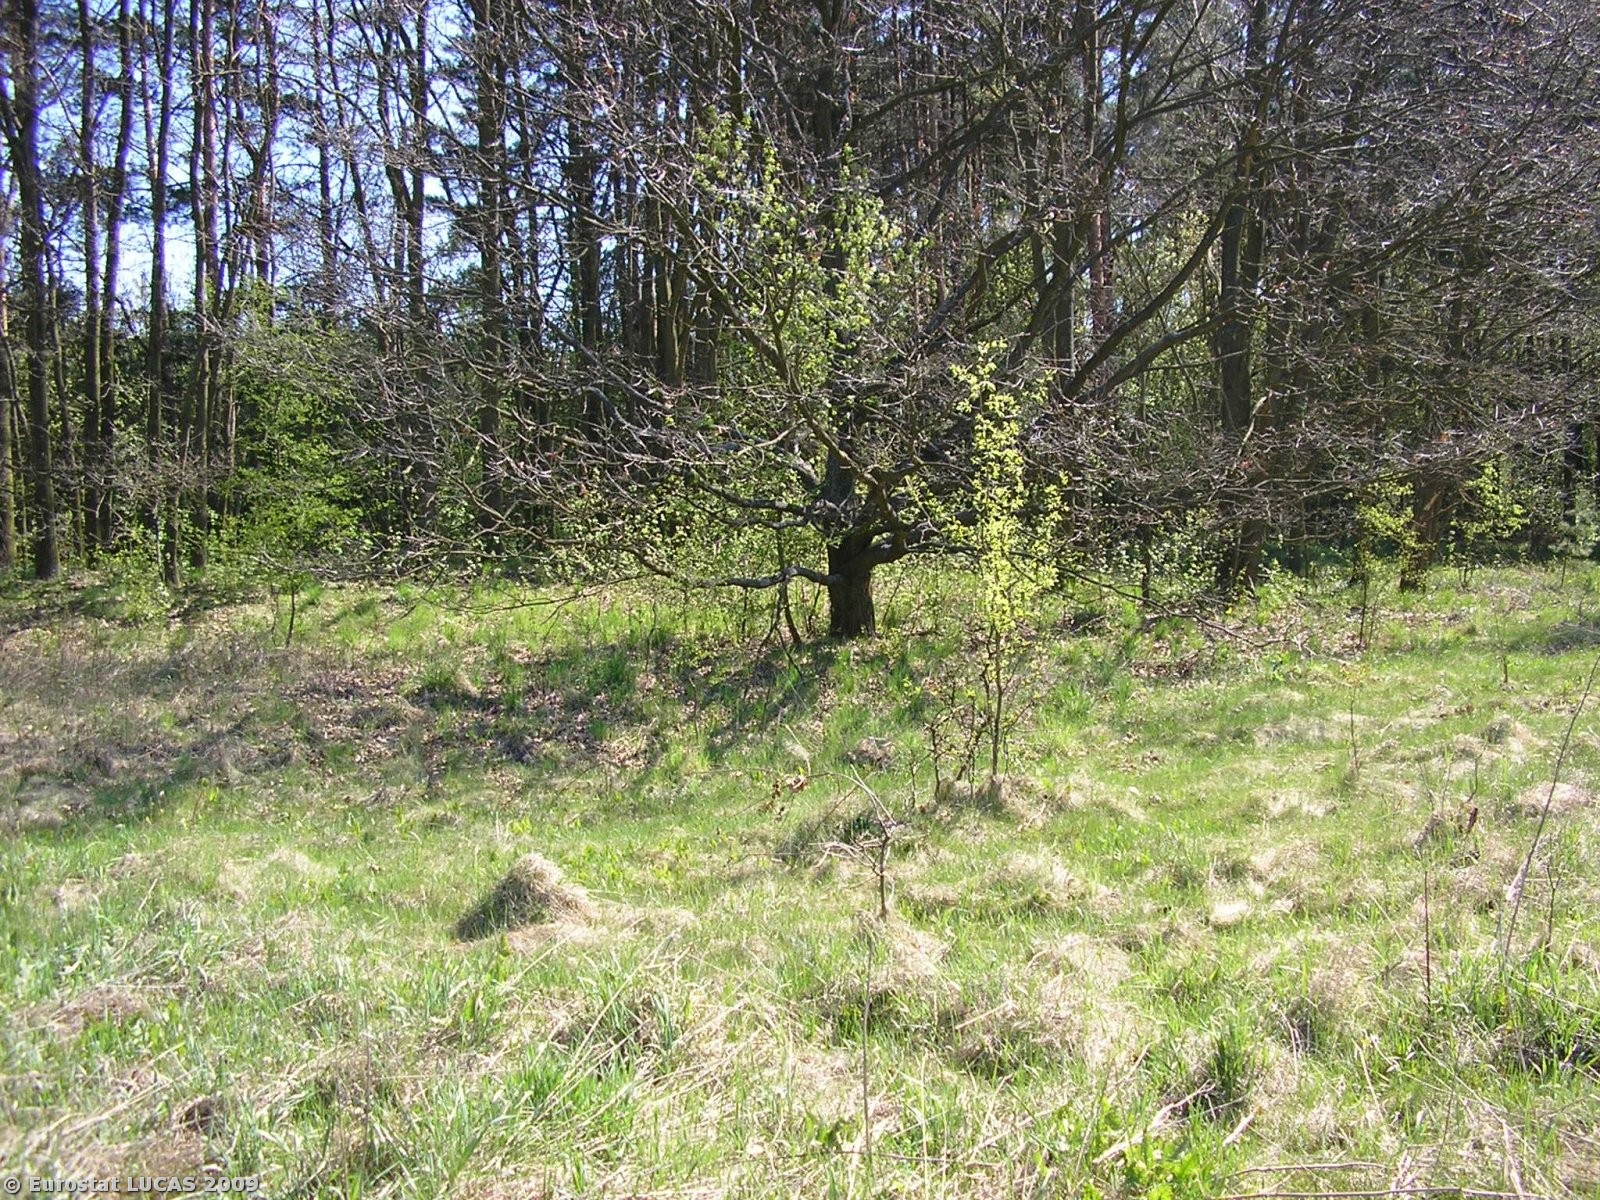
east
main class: Grassland
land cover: Grassland without tree/shrub cover
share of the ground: > 75 %
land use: Unused
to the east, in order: Grassland without tree/shrub cover; Grassland with sparse tree/shrub cover; Broadleaved woodland; Coniferous woodland; Grassland without tree/shrub cover; Tracks; Broadleaved woodland; Coniferous woodland; Broadleaved woodland
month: April
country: PL
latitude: 52.1753
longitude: 20.1683
